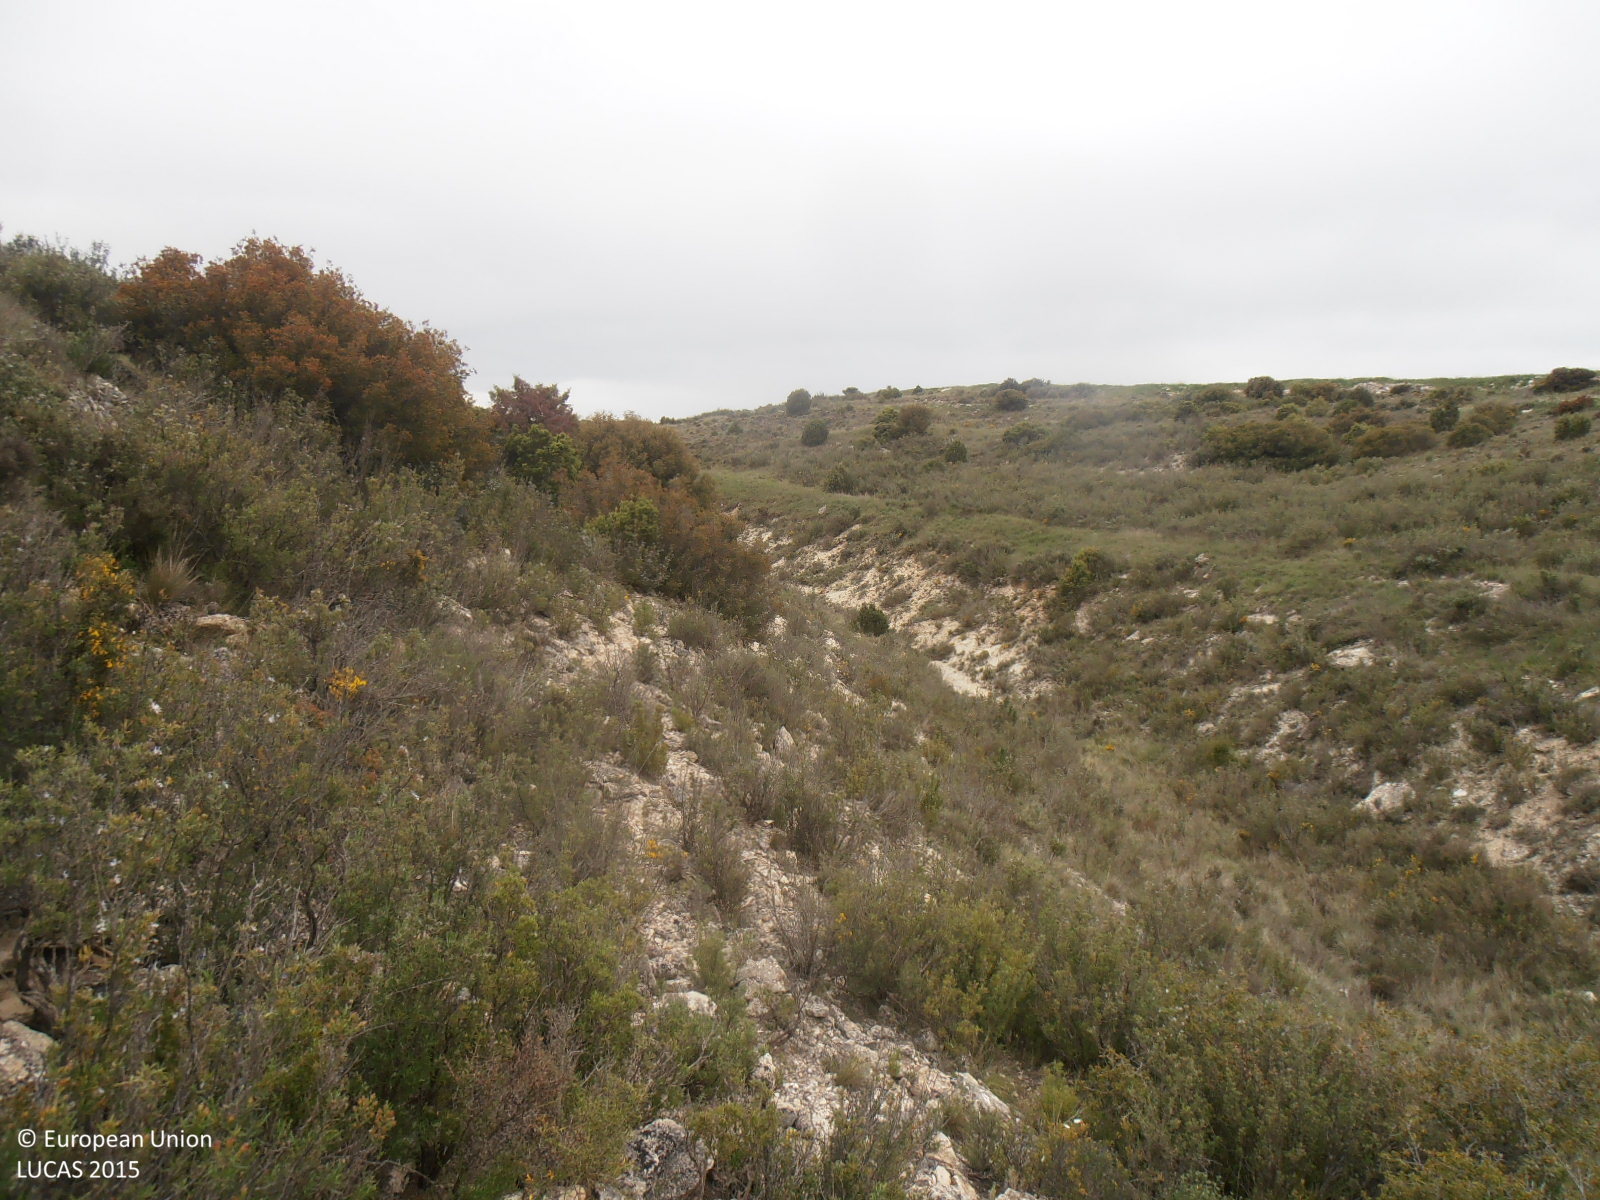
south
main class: Shrubland
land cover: Shrubland without tree cover
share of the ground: > 75 %
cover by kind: shrubs 65 %, consolidated bare surface 25 %, herbaceous plants 10 %
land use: Semi-natural and natural areas not in use
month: May
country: ES
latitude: 41.4164
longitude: -0.9915
